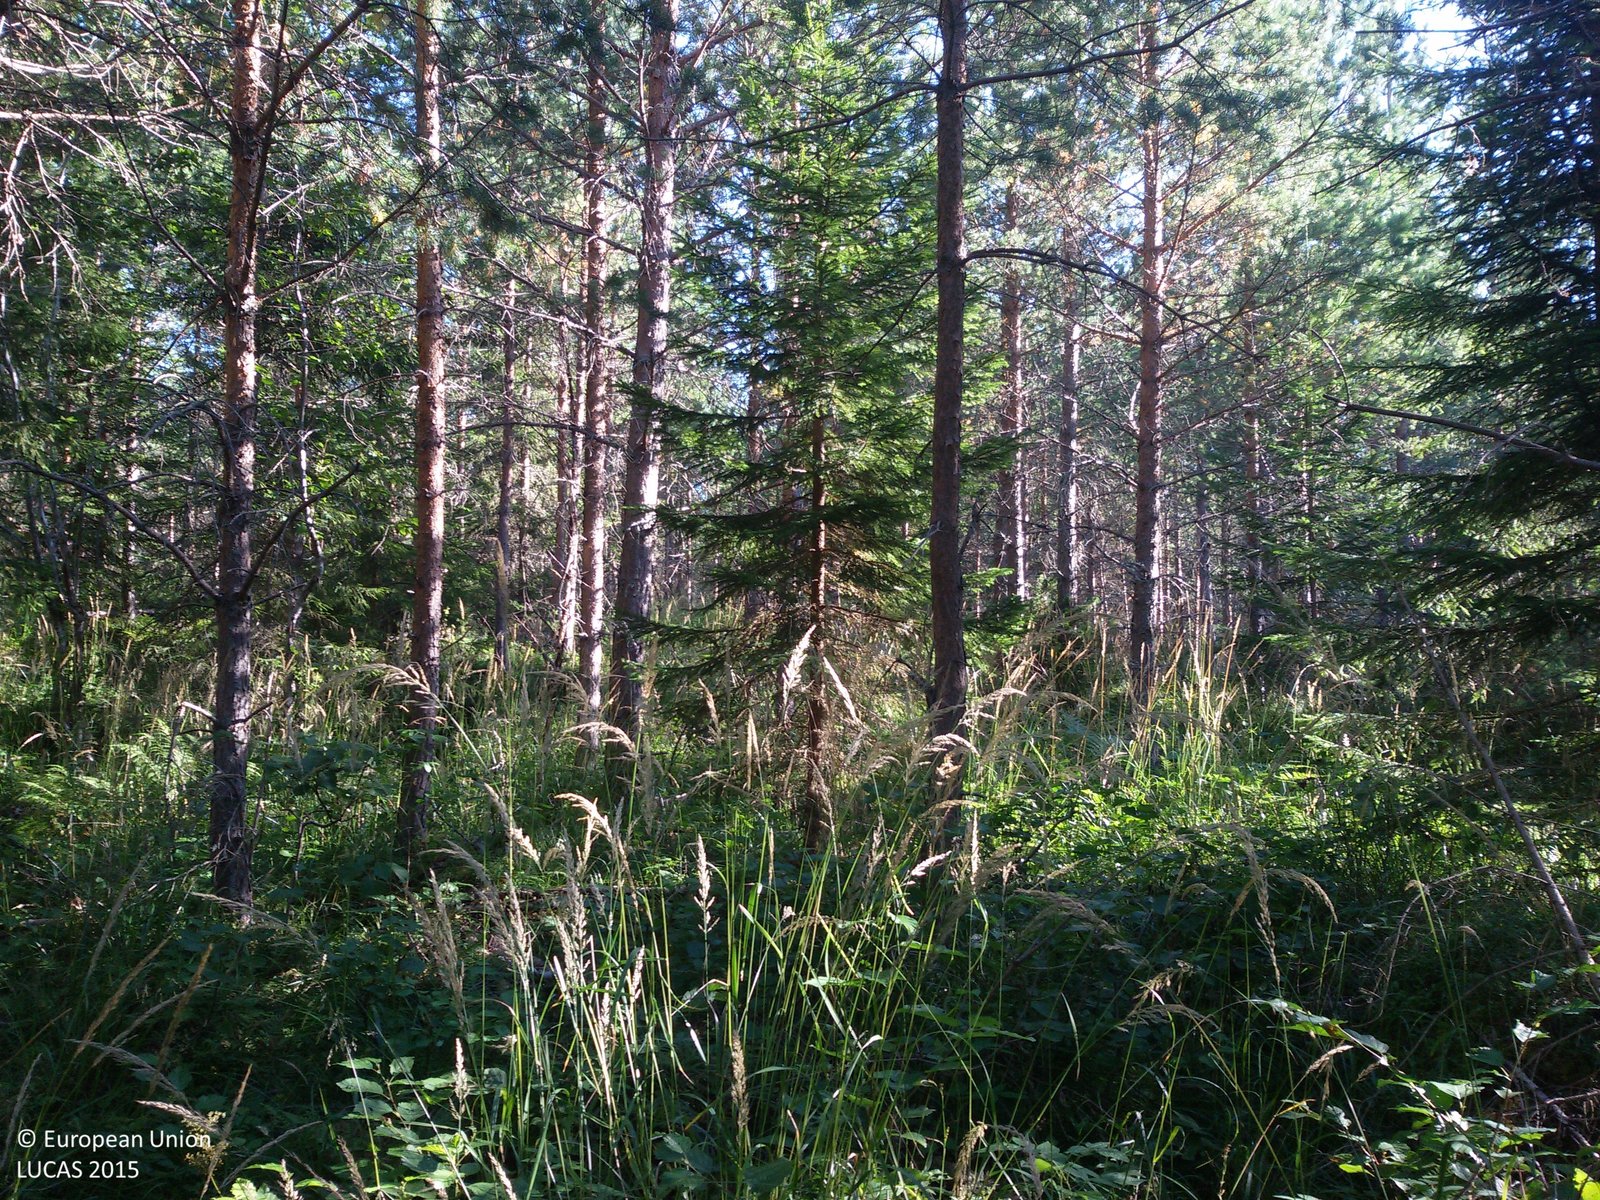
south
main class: Woodland
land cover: Pine dominated coniferous woodland
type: boreal forest
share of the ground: > 75 %
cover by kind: coniferous forest trees 80 %, shrubs 10 %, herbaceous plants 10 %
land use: Forestry
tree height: > 5 m
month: August
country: SE
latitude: 60.6534
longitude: 15.8956
